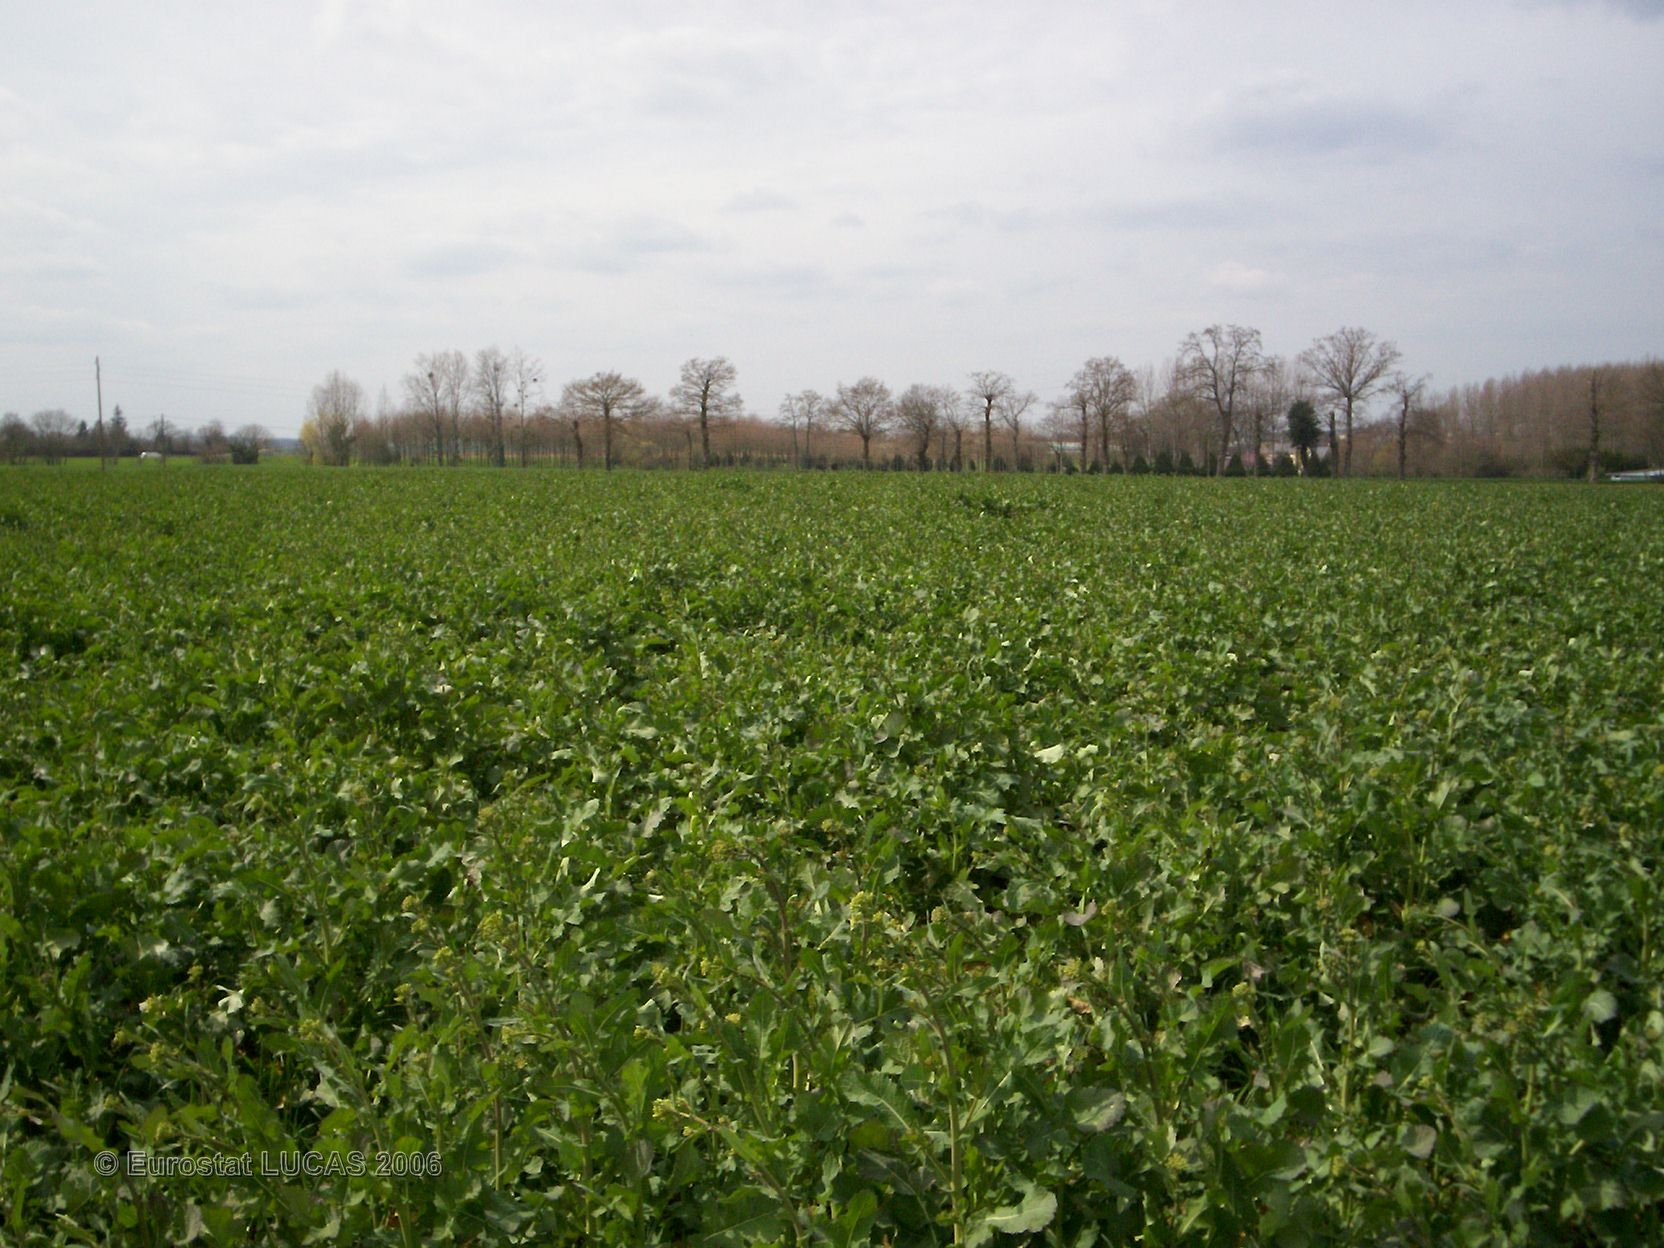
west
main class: Cropland
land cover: Rape and turnip rape
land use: Agriculture (excluding fallow land and kitchen gardens)
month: April
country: FR
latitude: 47.9923
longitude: -1.5841
